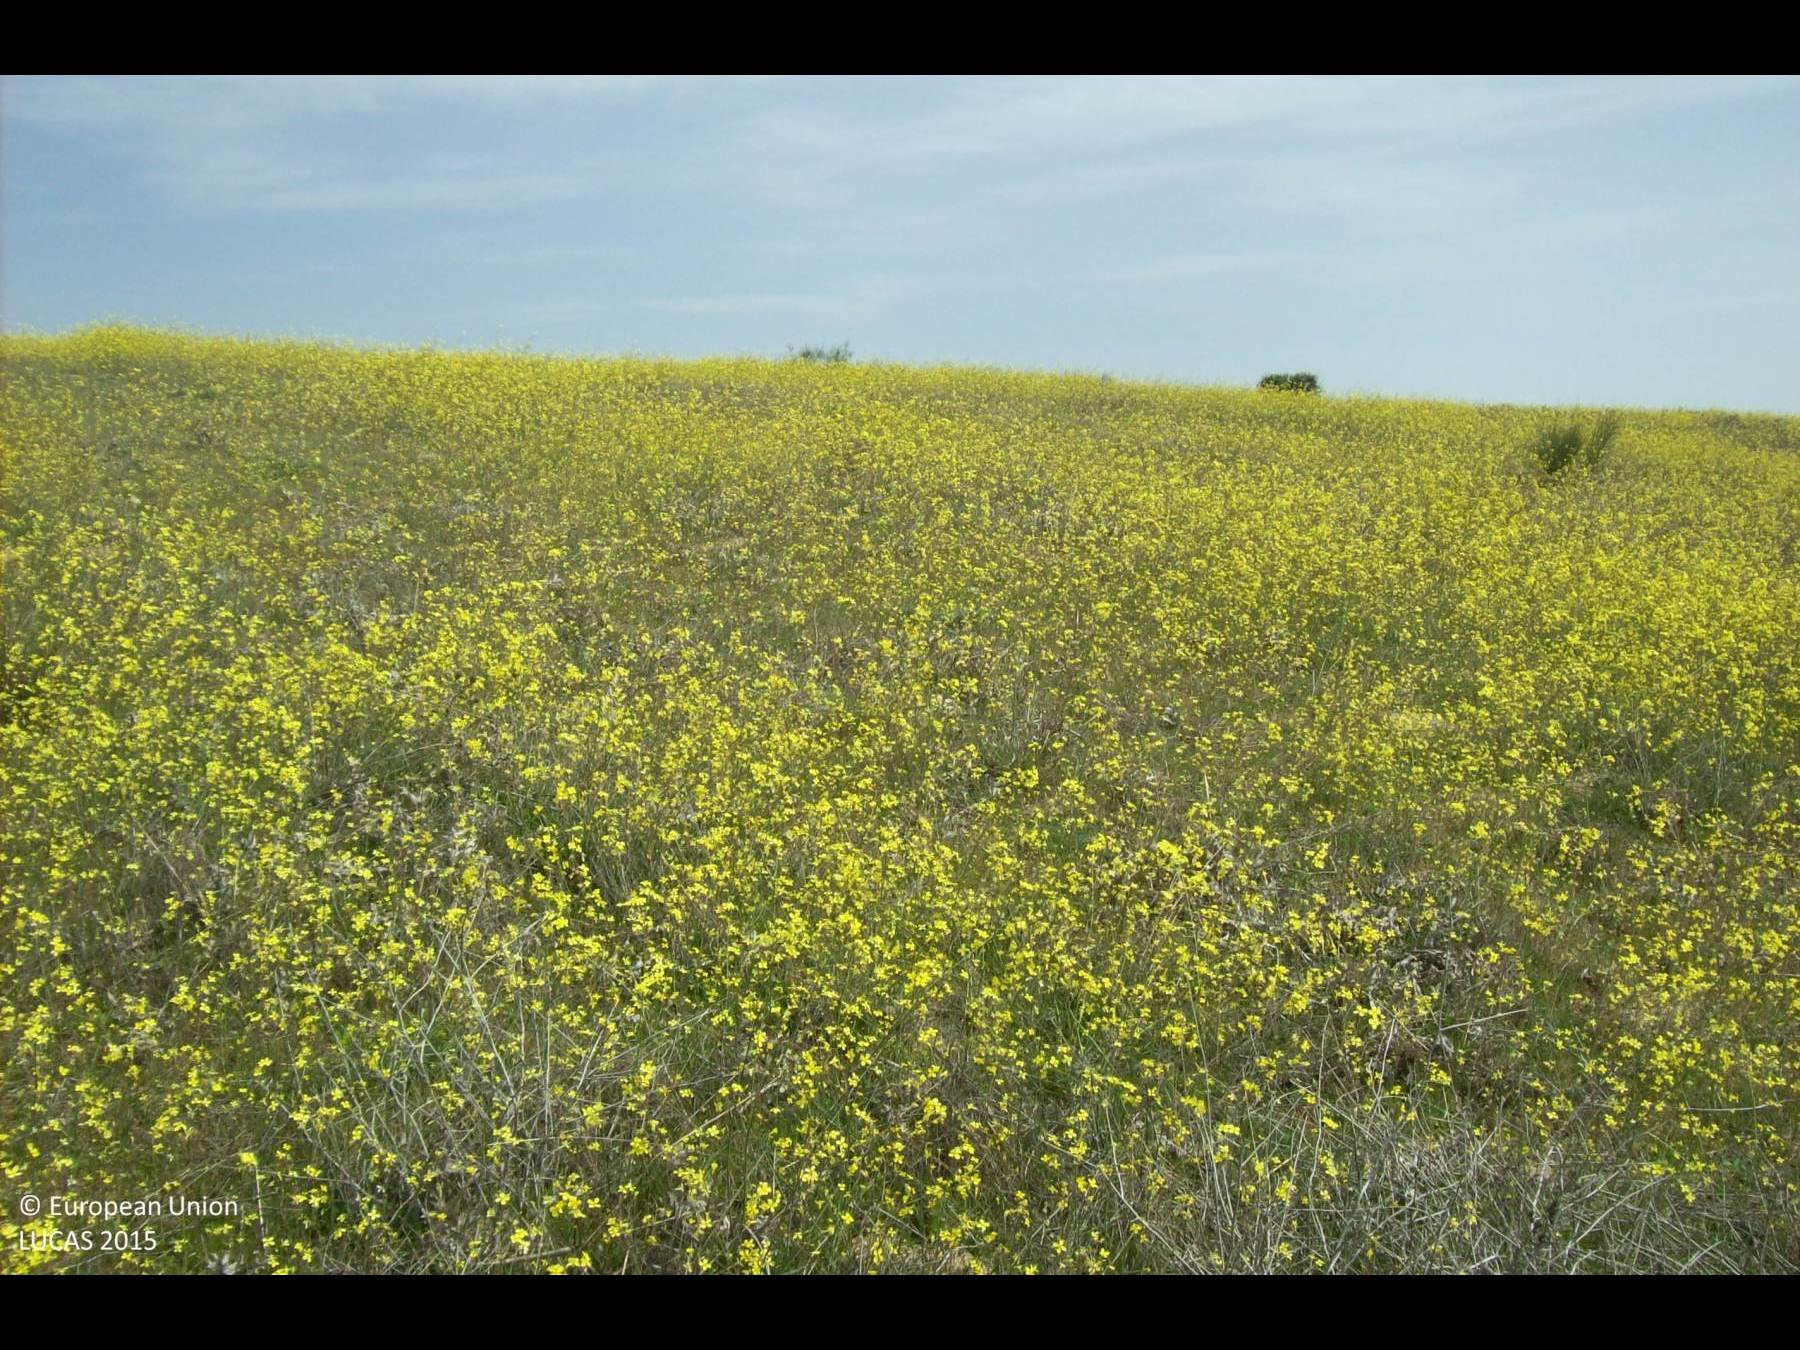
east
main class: Grassland
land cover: Spontaneously vegetated surfaces
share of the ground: > 75 %
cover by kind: herbaceous plants 95 %, shrubs 5 %
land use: Semi-natural and natural areas not in use
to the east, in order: Spontaneously vegetated surfaces; Grassland with sparse tree/shrub cover
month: April
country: ES
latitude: 40.3817
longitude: -3.8322
